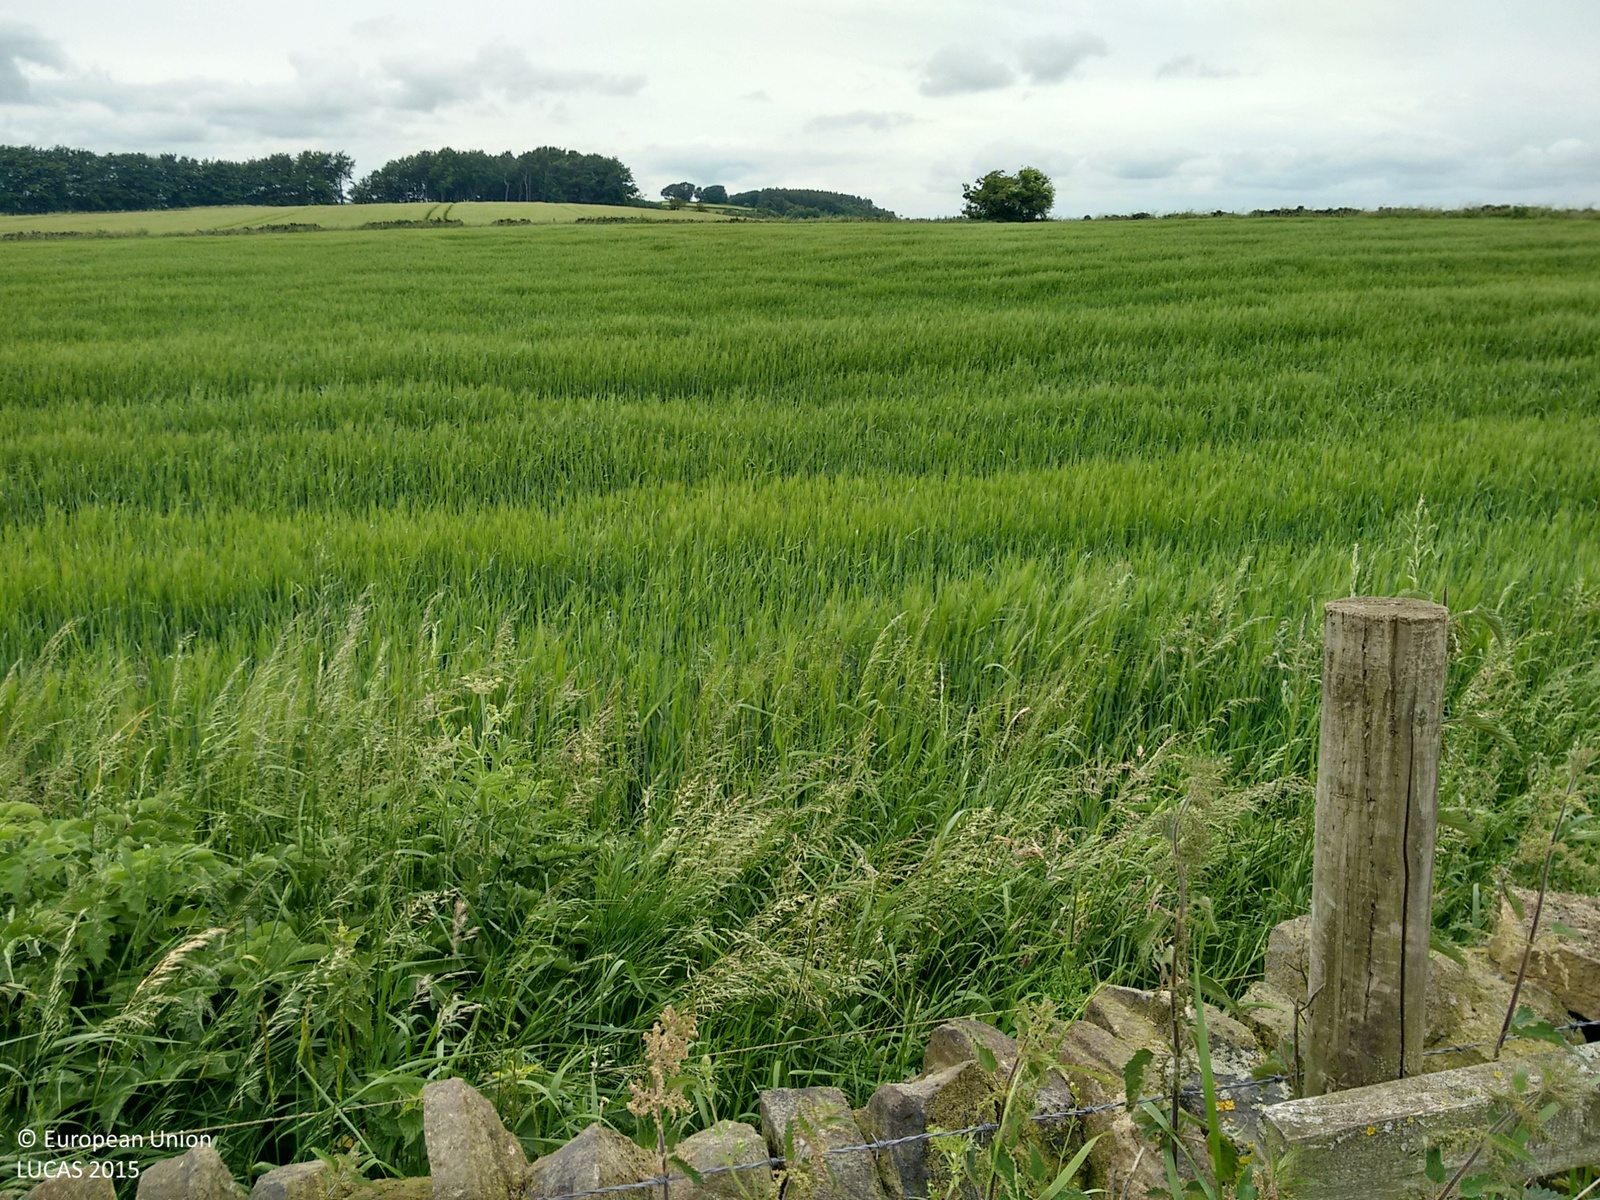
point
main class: Cropland
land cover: Barley
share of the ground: > 75 %
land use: Agriculture (excluding fallow land and kitchen gardens)
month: July
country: GB
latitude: 53.1439
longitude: -1.4873
